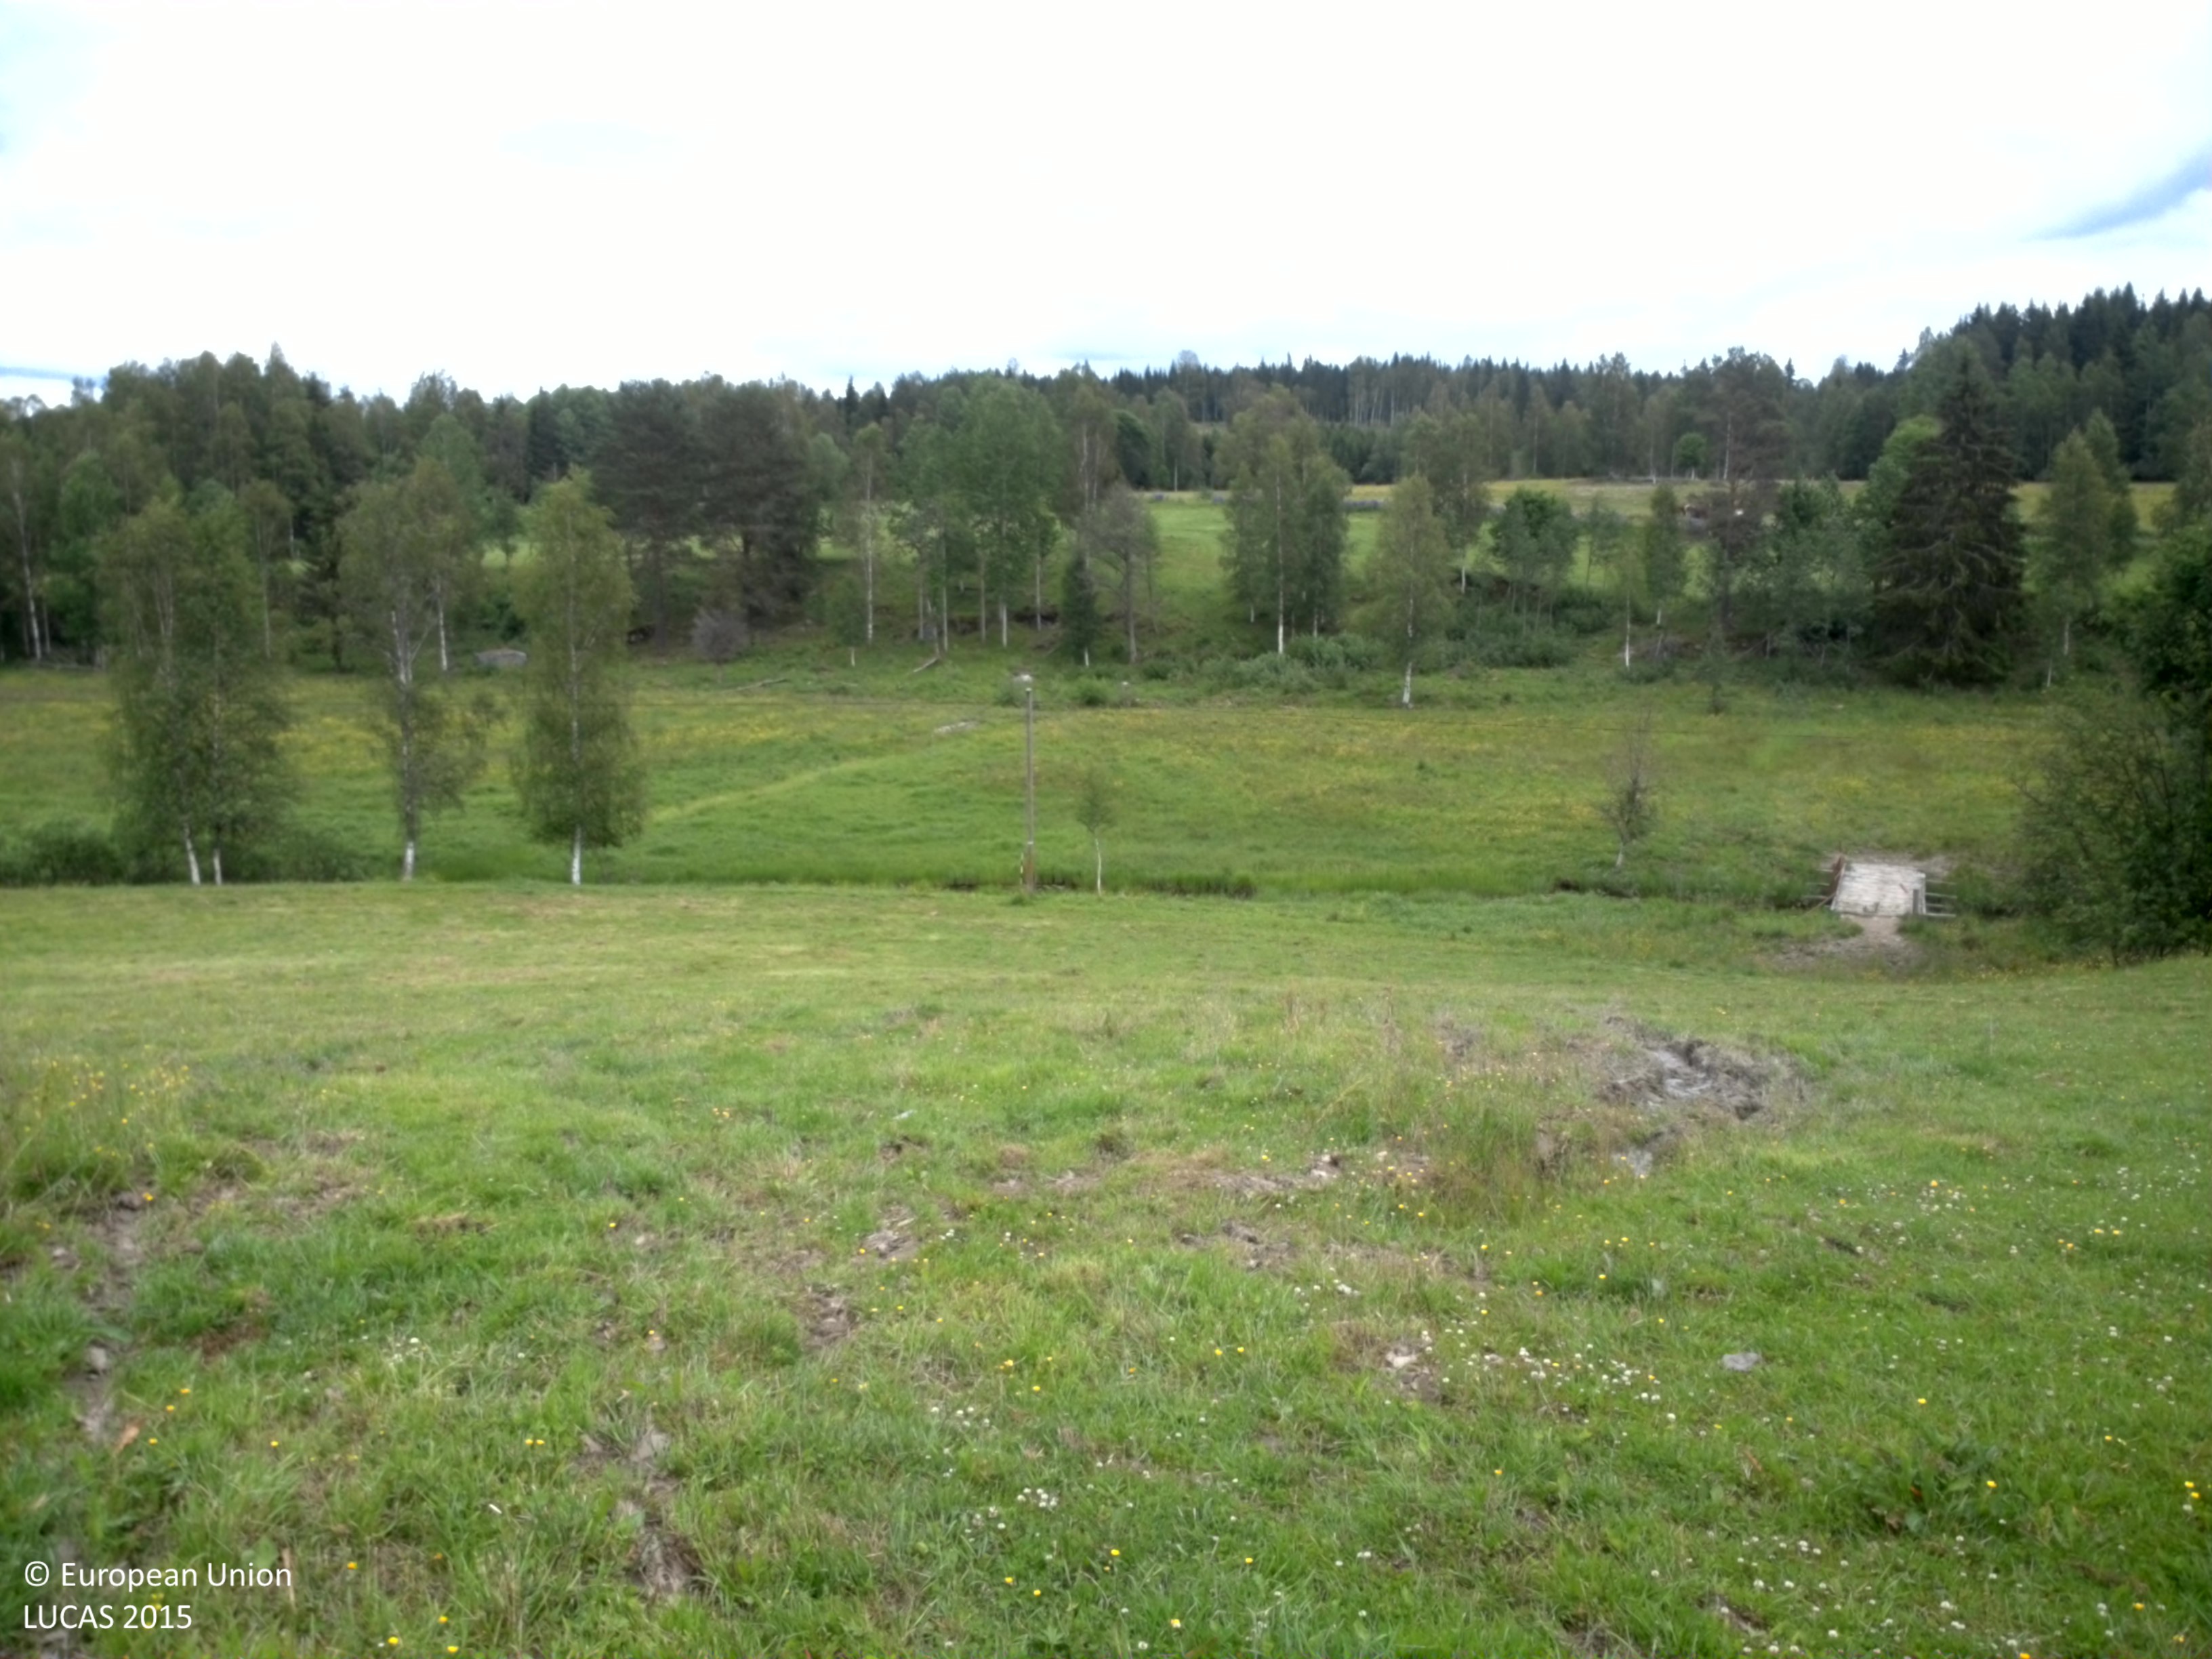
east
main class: Grassland
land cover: Grassland without tree/shrub cover
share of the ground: > 75 %
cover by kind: herbaceous plants 90 %, unconsolidated bare surface 10 %
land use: Agriculture (excluding fallow land and kitchen gardens)
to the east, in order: Grassland without tree/shrub cover; Electric lines; Rivers and streams; Grassland without tree/shrub cover; Broadleaved woodland; Grassland without tree/shrub cover; Electric lines; Fences; Grass margins; Paved roads, cycling and walking lanes; Grass margins; Fences; Grassland without tree/shrub cover
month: June
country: SE
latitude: 59.7815
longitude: 12.4337
